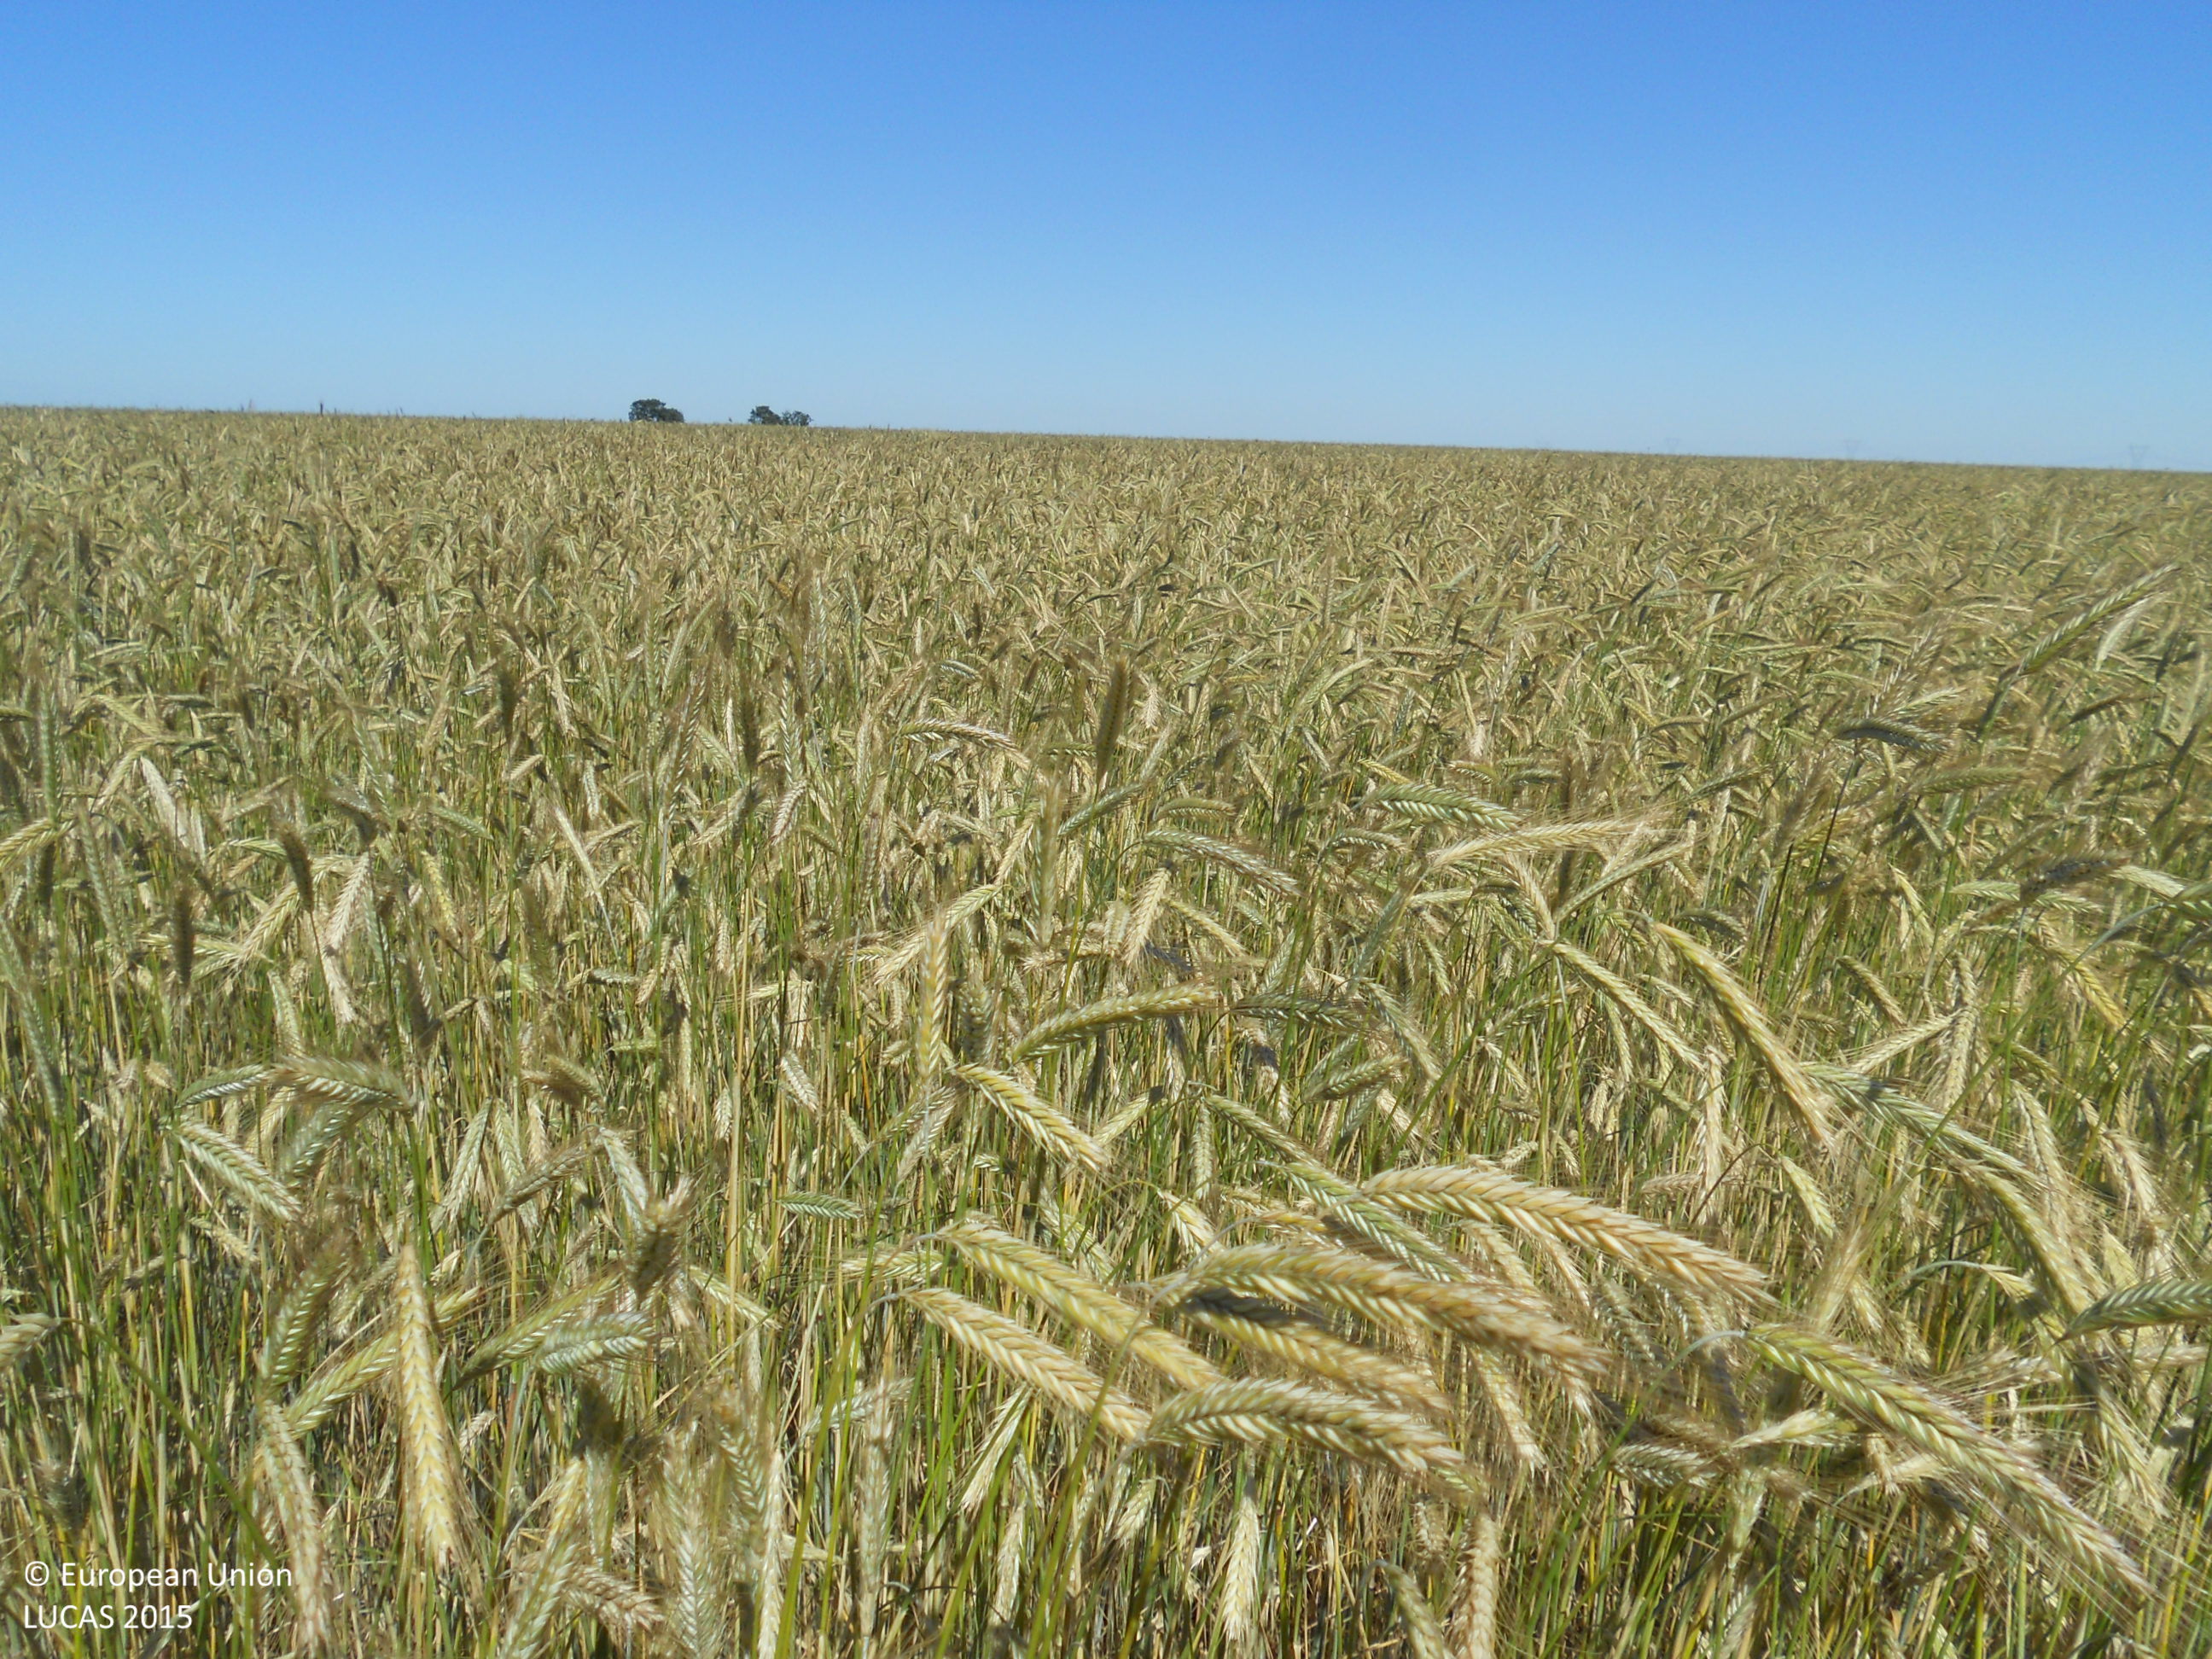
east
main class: Cropland
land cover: Rye
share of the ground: > 75 %
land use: Agriculture (excluding fallow land and kitchen gardens)
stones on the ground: > 50 %
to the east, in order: Rye; Other bare soil
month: June
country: ES
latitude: 42.4535
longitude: -4.8303
